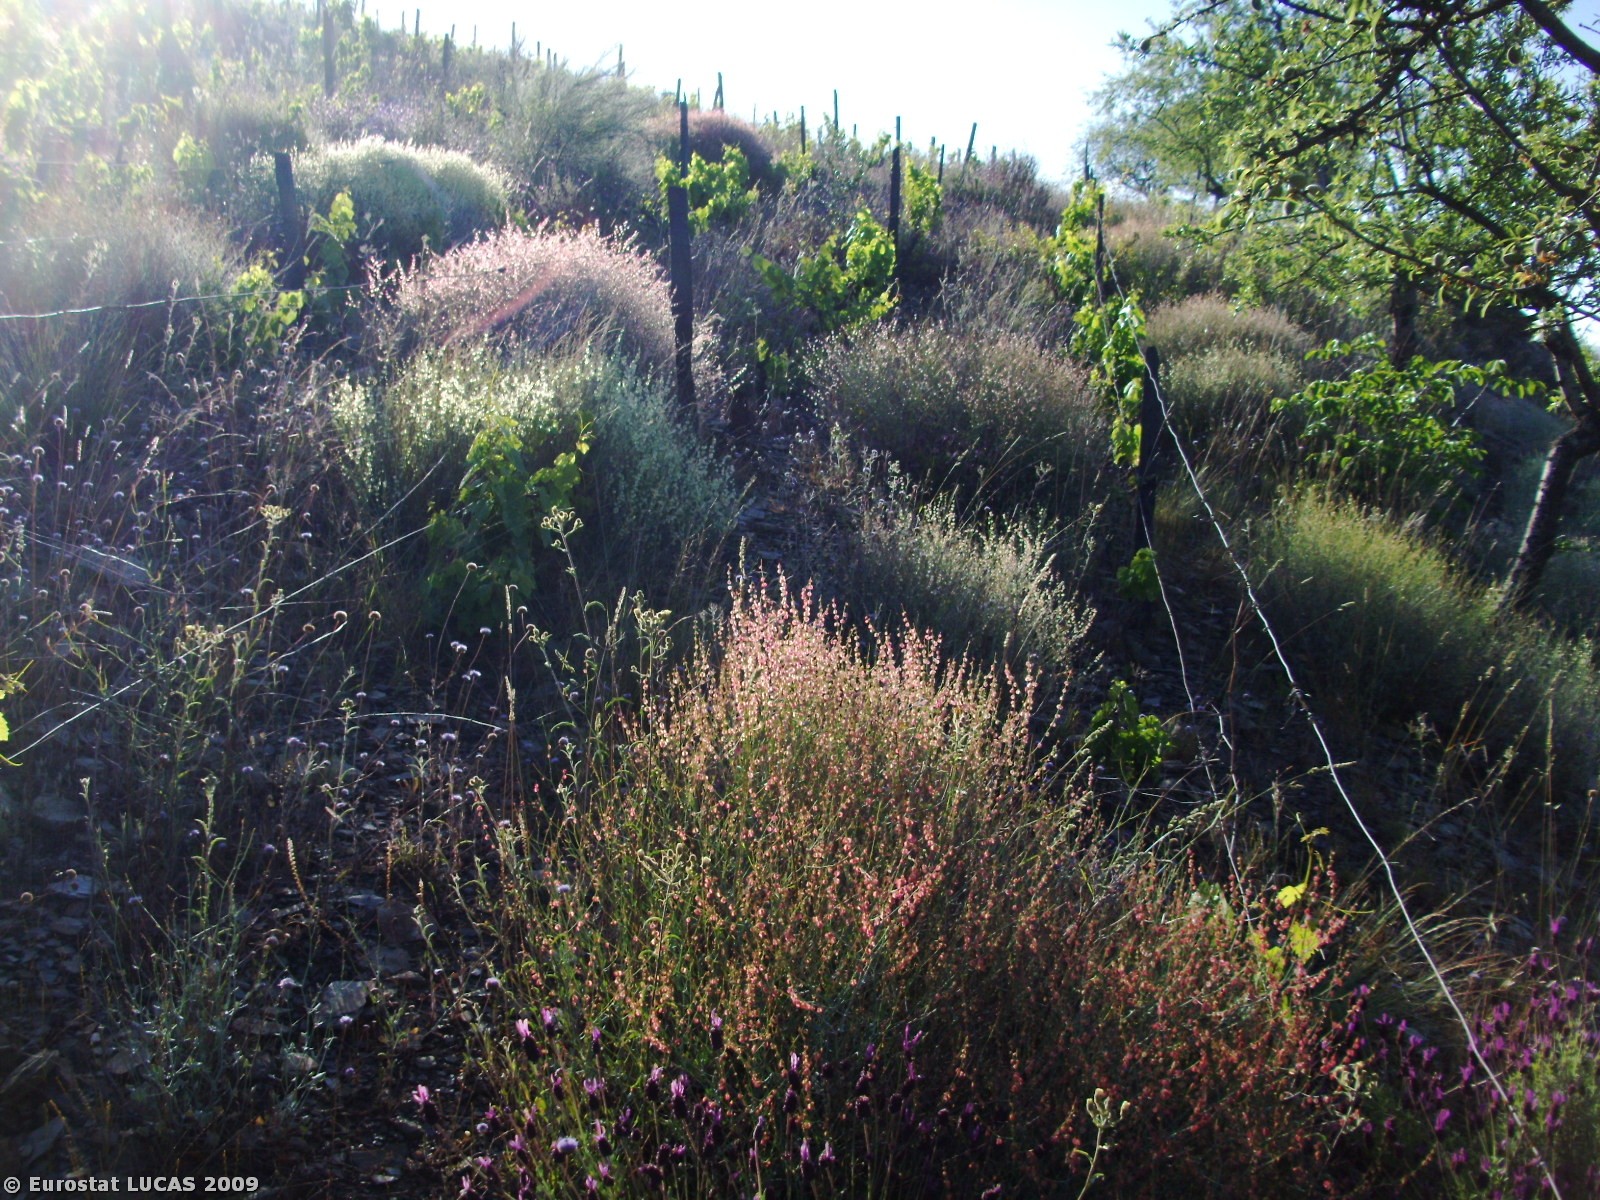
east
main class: Shrubland
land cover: Shrubland without tree cover
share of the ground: > 75 %
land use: Unused
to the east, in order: Shrubland without tree cover; Lines of trees; Vineyards; Tracks; Shrubland without tree cover; Tracks; Shrubland without tree cover; Tracks; Shrubland without tree cover
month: May
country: PT
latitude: 41.0984
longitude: -7.3941
